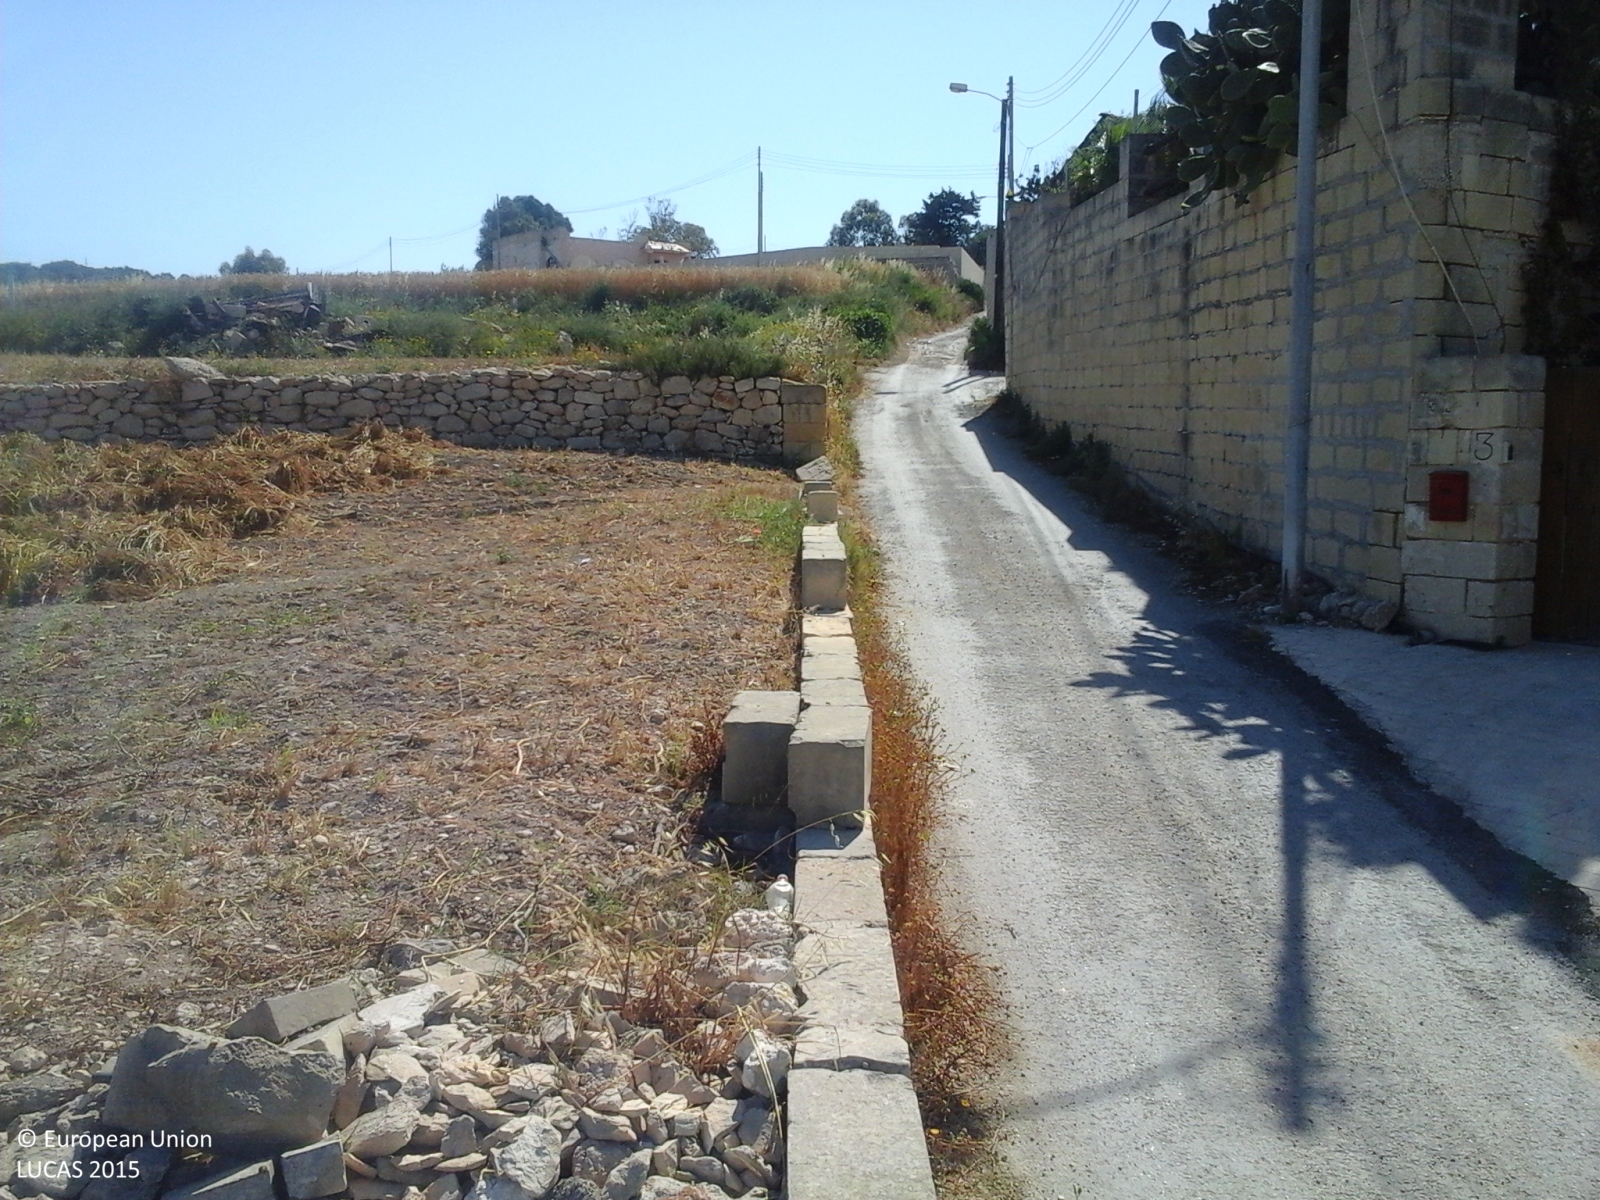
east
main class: Grassland
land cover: Grassland without tree/shrub cover
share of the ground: > 75 %
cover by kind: herbaceous plants 60 %, shrubs 5 %
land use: Abandoned areas
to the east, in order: Grassland without tree/shrub cover; Artificial constructions in urban areas; Other leguminous and mixtures for fodder; Grass margins; Lines of trees; Durum wheat; Grass margins; Dry stone walls; Durum wheat; Grass margins; Dry stone walls; Mixed cereals for fodder; Dry stone walls; Mixed cereals for fodder; Dry stone walls; Tracks; Other fresh vegetables; Dry stone walls; Dry pulses; Dry stone walls; Mixed cereals for fodder
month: May
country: MT
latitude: 35.8368
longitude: 14.5521
